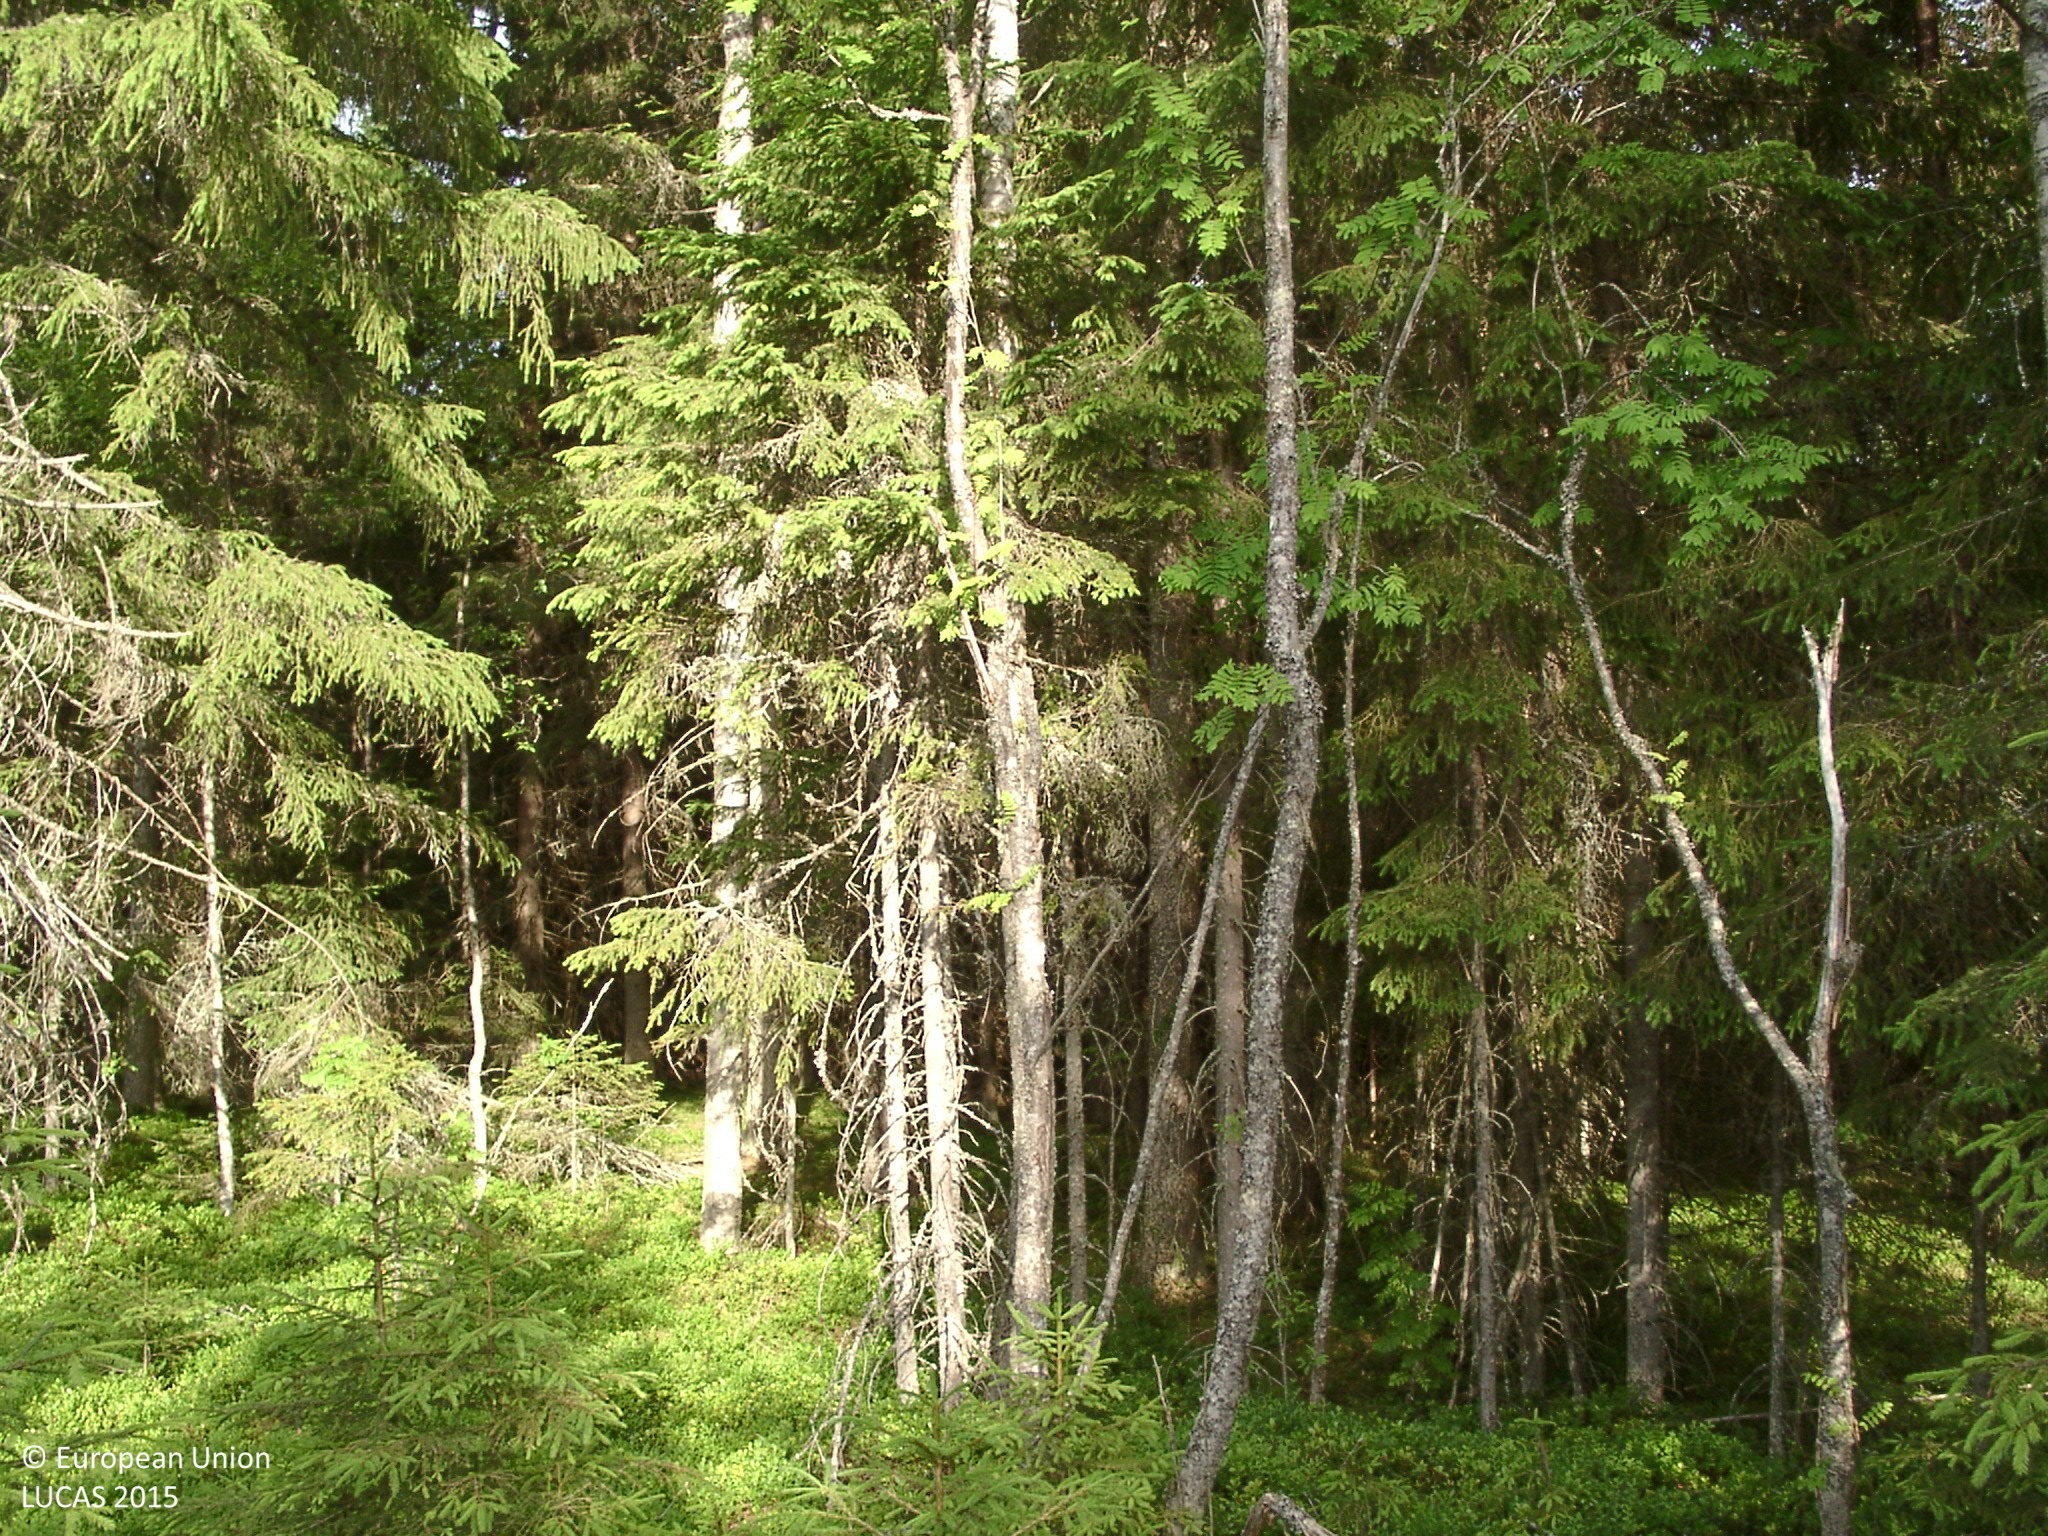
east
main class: Woodland
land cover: Spruce dominated coniferous woodland
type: boreal forest
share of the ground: 50 - 75 %
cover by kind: coniferous forest trees 55 %, shrubs 25 %, herbaceous plants 10 %, broadleaved forest trees 5 %, lichens and mosses 5 %
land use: Forestry
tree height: > 5 m
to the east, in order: Spruce dominated coniferous woodland; Grass margins; Spruce dominated mixed woodland; Grass margins; Spruce dominated mixed woodland; Grass margins; Spruce dominated coniferous woodland; Tracks; Spruce dominated coniferous woodland
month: July
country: FI
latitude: 62.0316
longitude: 25.4244
